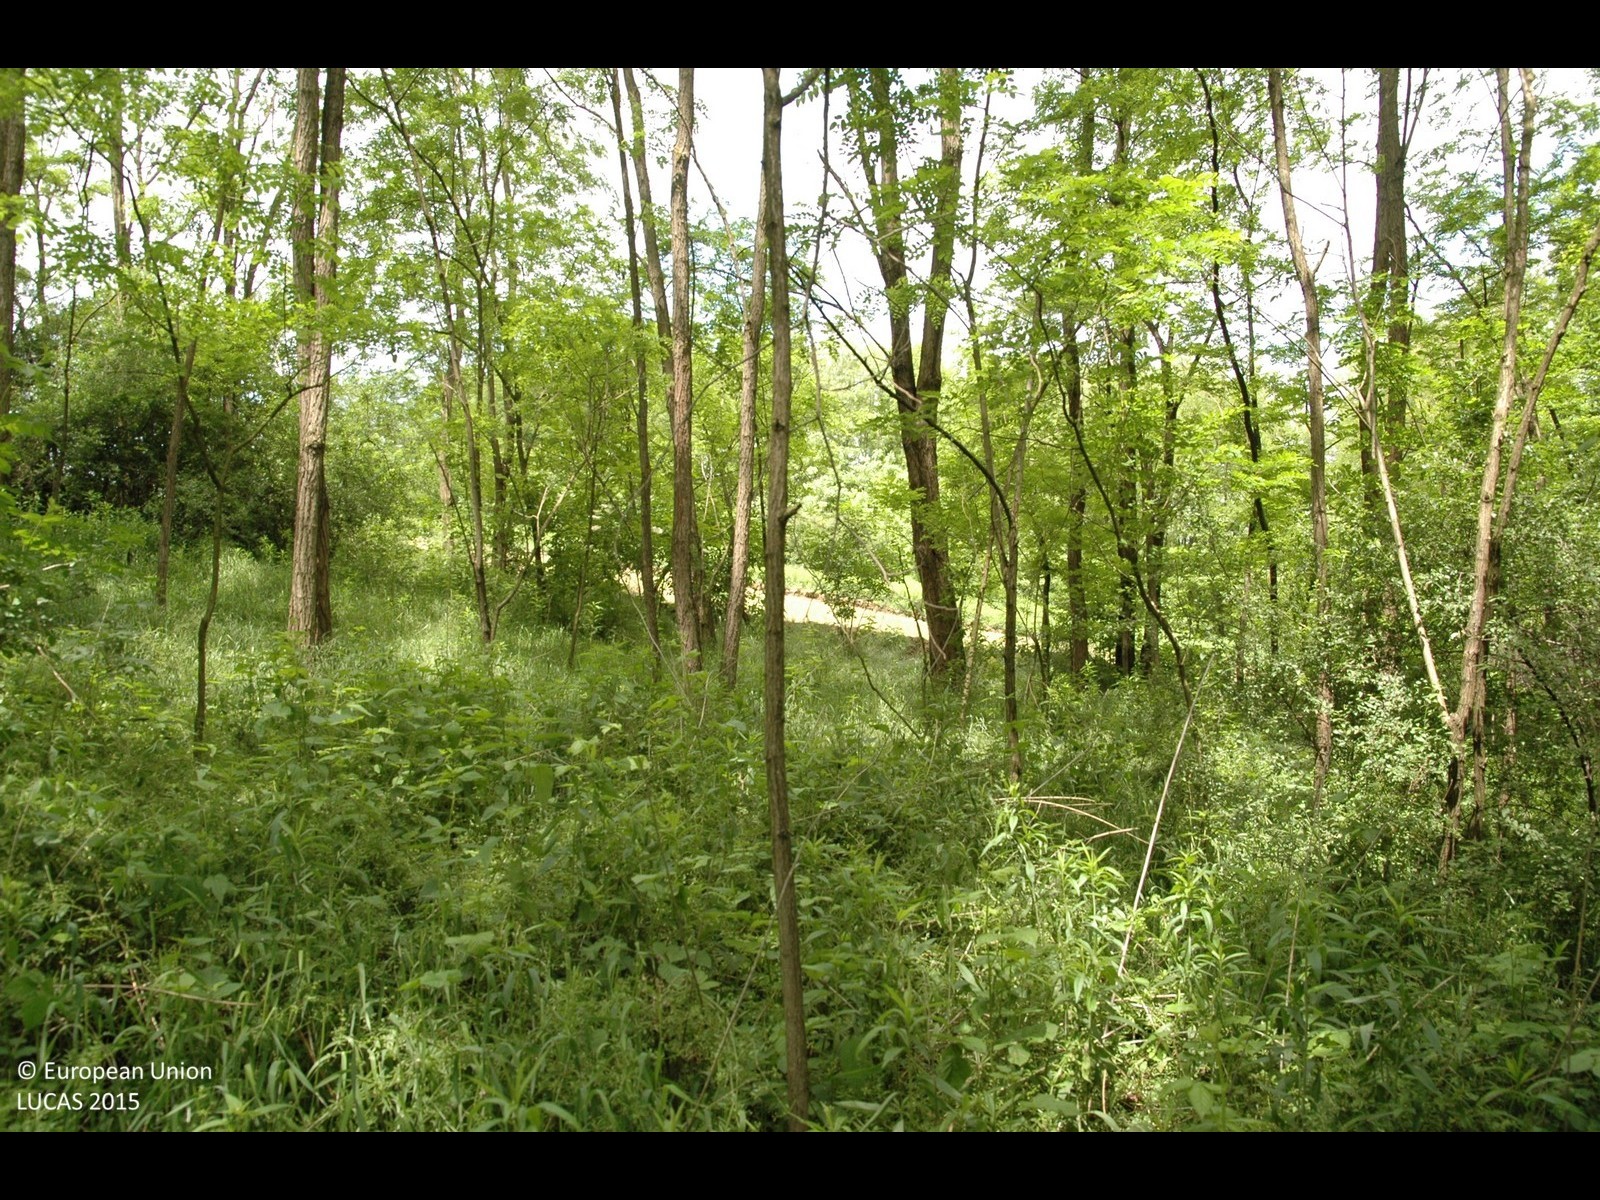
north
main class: Woodland
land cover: Broadleaved woodland
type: mesophytic deciduous forest
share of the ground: > 75 %
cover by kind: broadleaved forest trees 90 %, shrubs 5 %, herbaceous plants 5 %
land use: Forestry
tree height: > 5 m
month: May
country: HR
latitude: 46.4100
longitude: 16.4401
